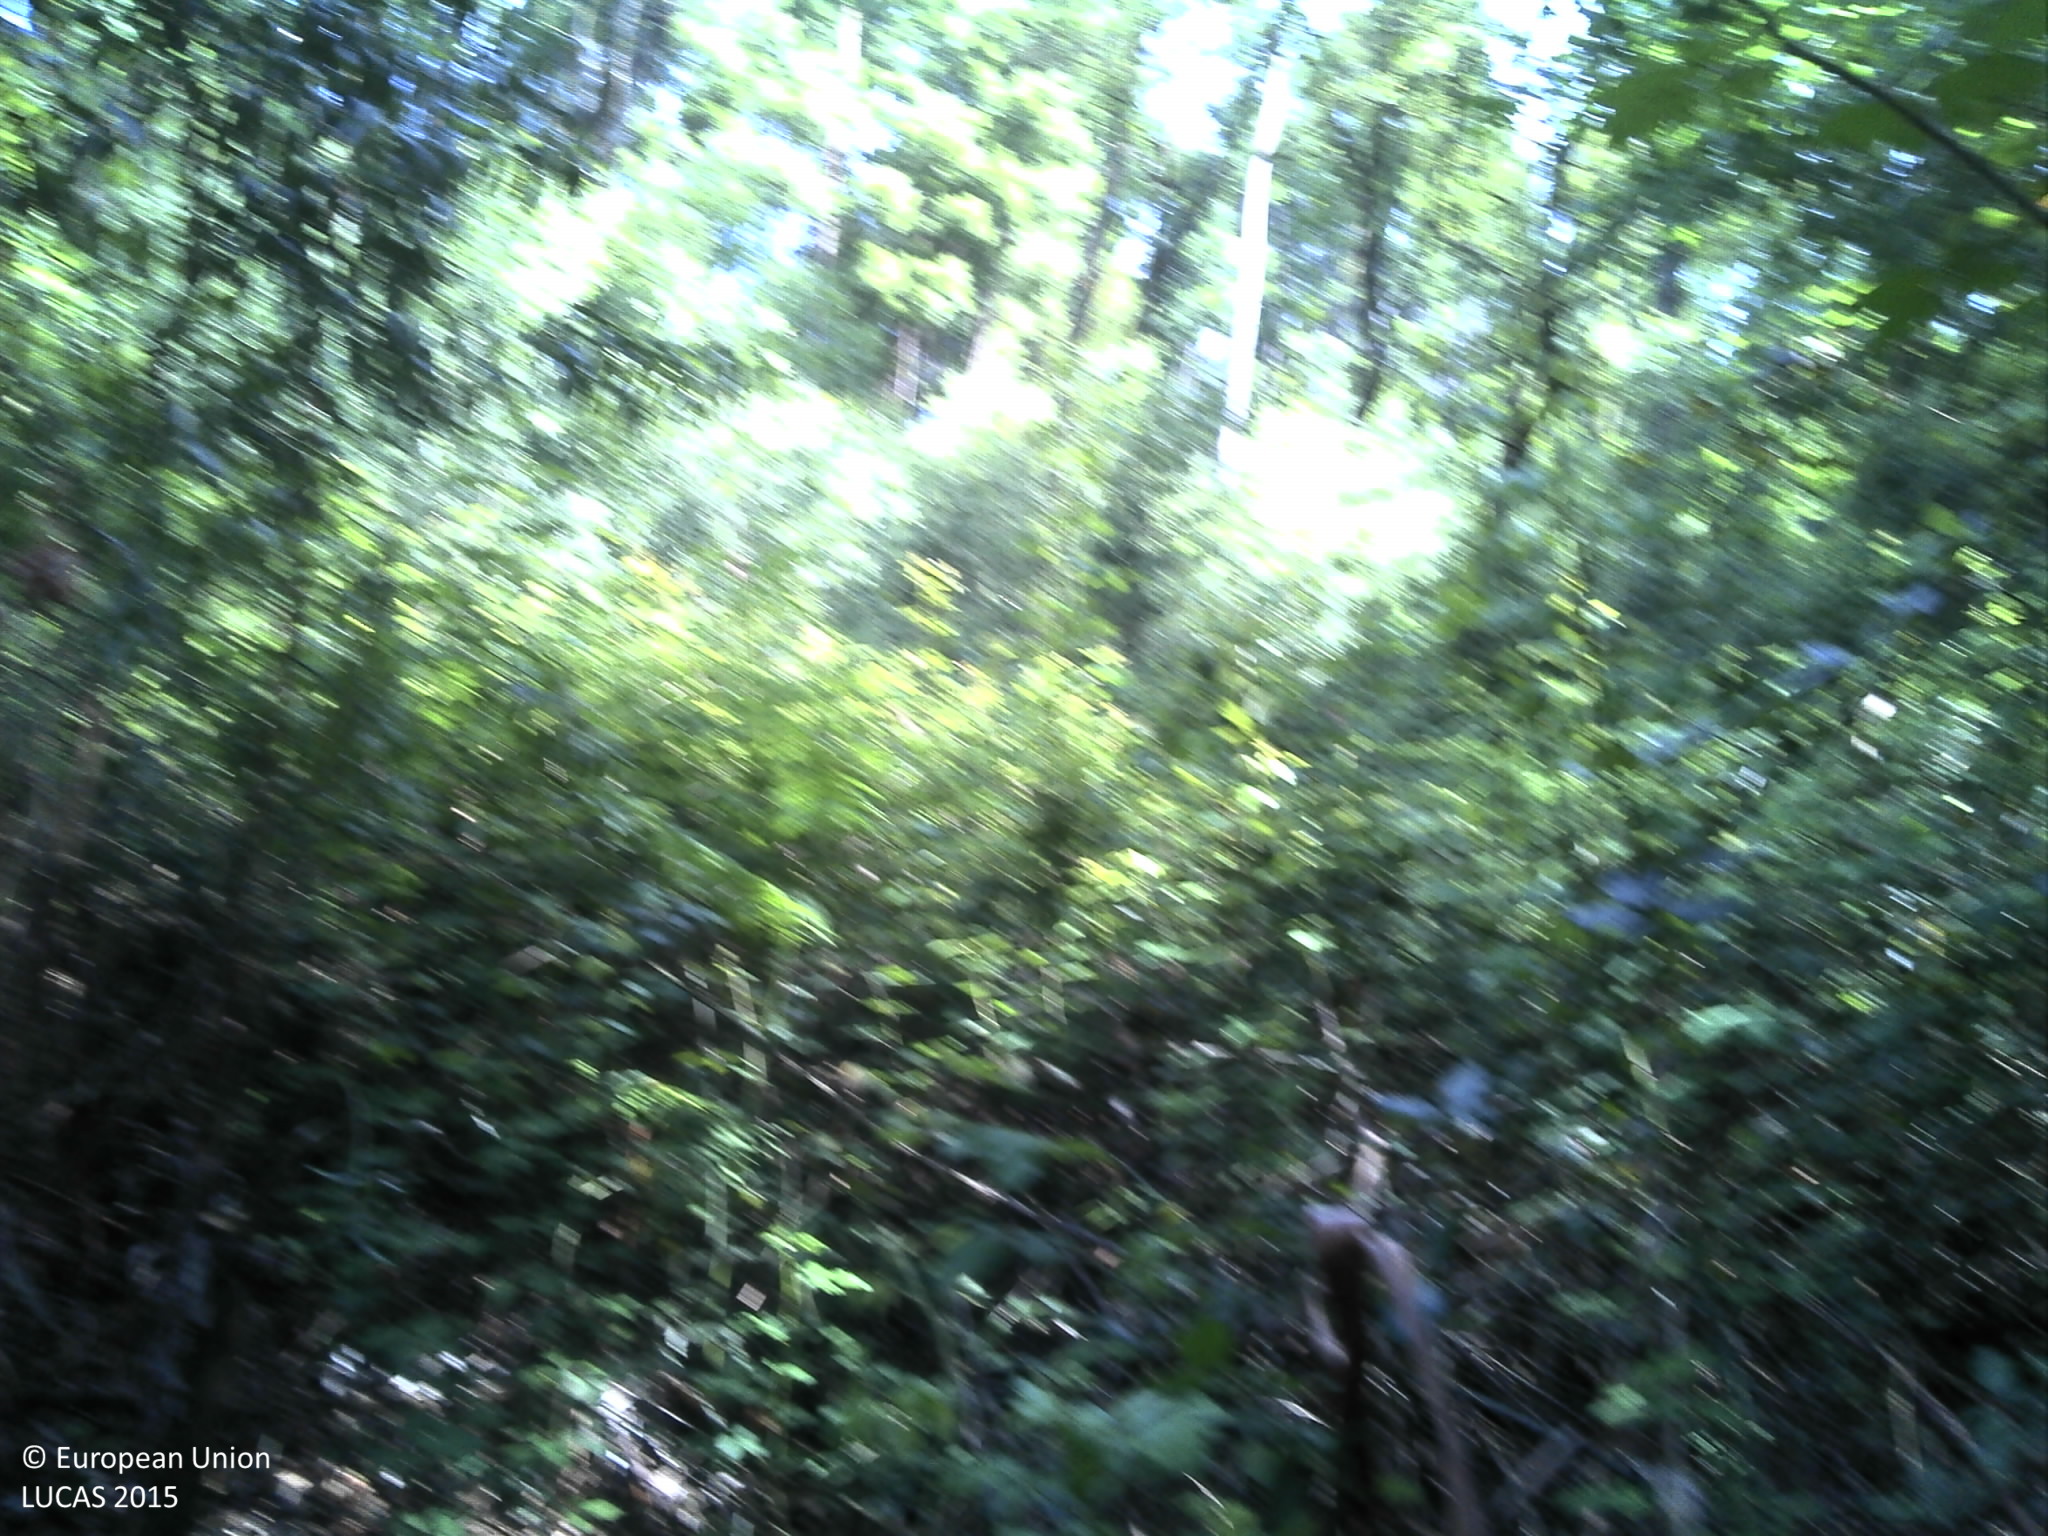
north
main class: Woodland
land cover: Broadleaved woodland
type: exotic forest
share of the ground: > 75 %
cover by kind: broadleaved forest trees 85 %, shrubs 10 %, unconsolidated bare surface 5 %
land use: Forestry
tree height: > 5 m
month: May
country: PT
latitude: 41.0816
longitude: -8.5888
